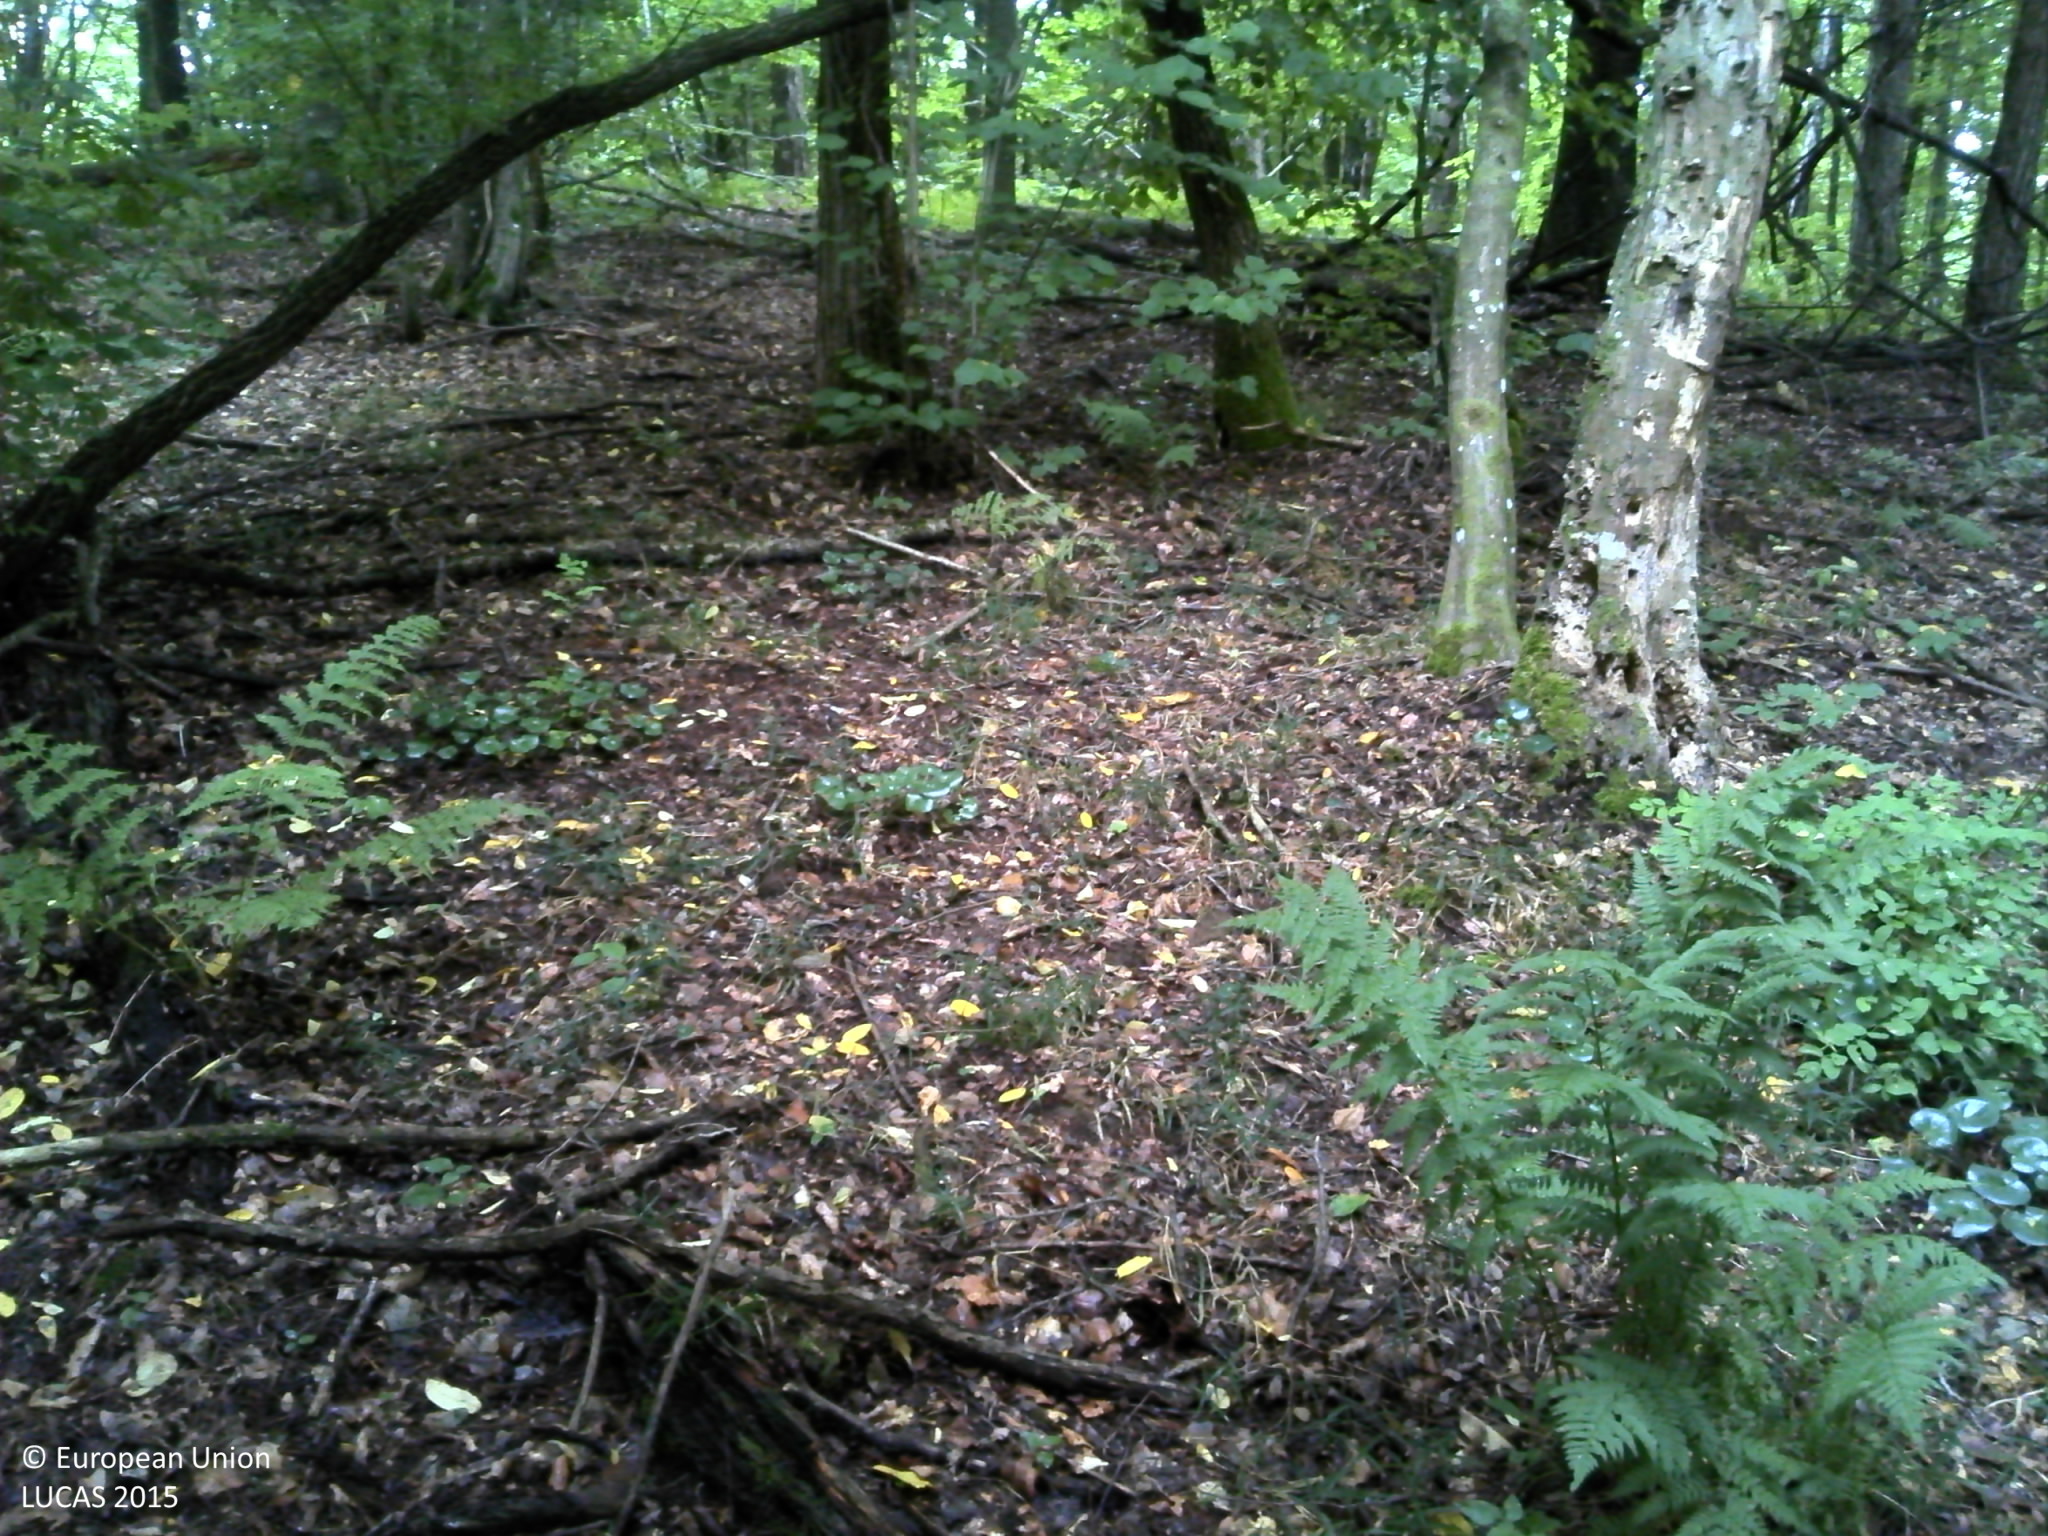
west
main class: Woodland
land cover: Broadleaved woodland
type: acidophilous oak and oak-birch forest
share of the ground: > 75 %
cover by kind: broadleaved forest trees 100 %
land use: Forestry
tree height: > 5 m
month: August
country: HR
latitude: 45.4263
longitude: 15.6326
